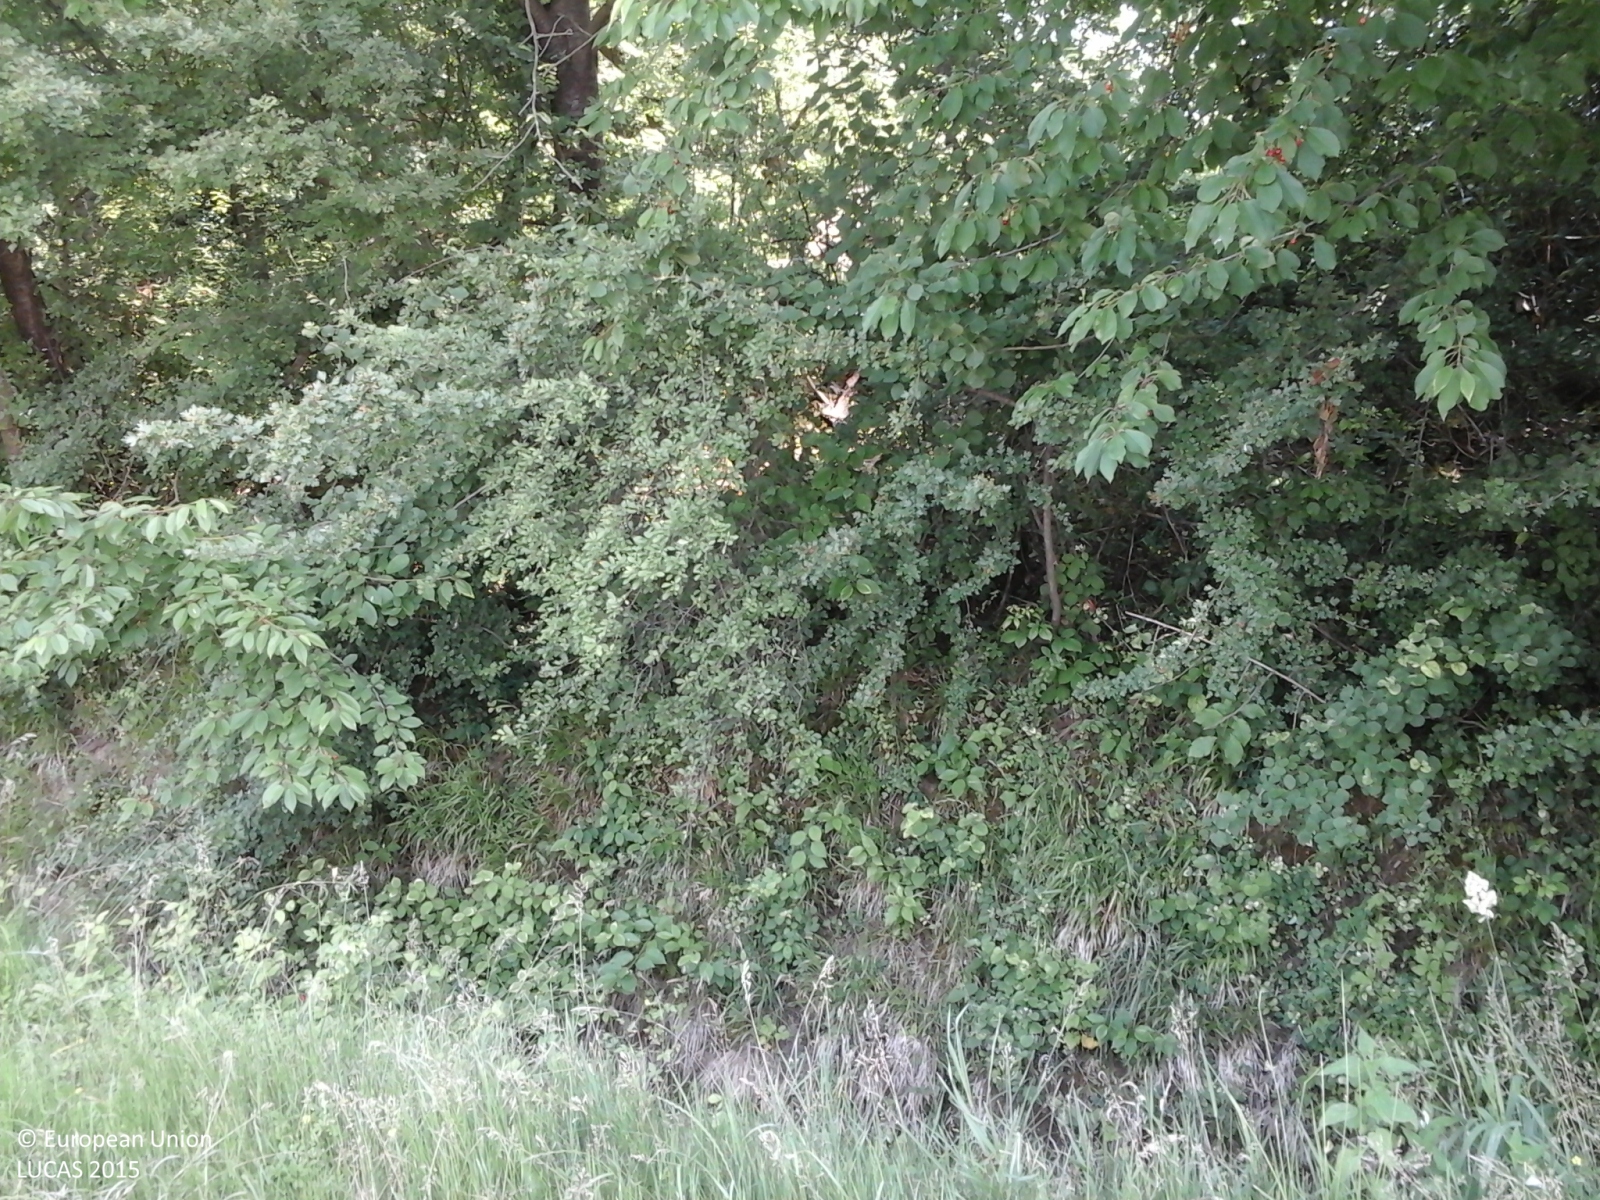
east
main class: Cropland
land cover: Rice
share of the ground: < 10 %
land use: Agriculture (excluding fallow land and kitchen gardens)
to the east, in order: Rice; Grassland without tree/shrub cover; Ditches and canals; Broadleaved woodland; Tracks; Grass margins; Inland fresh running water; Paved roads, cycling and walking lanes; Grassland without tree/shrub cover; Broadleaved woodland; Ditches and canals; Tracks; Rice; Other structural elements; Rice
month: May
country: IT
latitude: 45.4183
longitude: 8.2777
